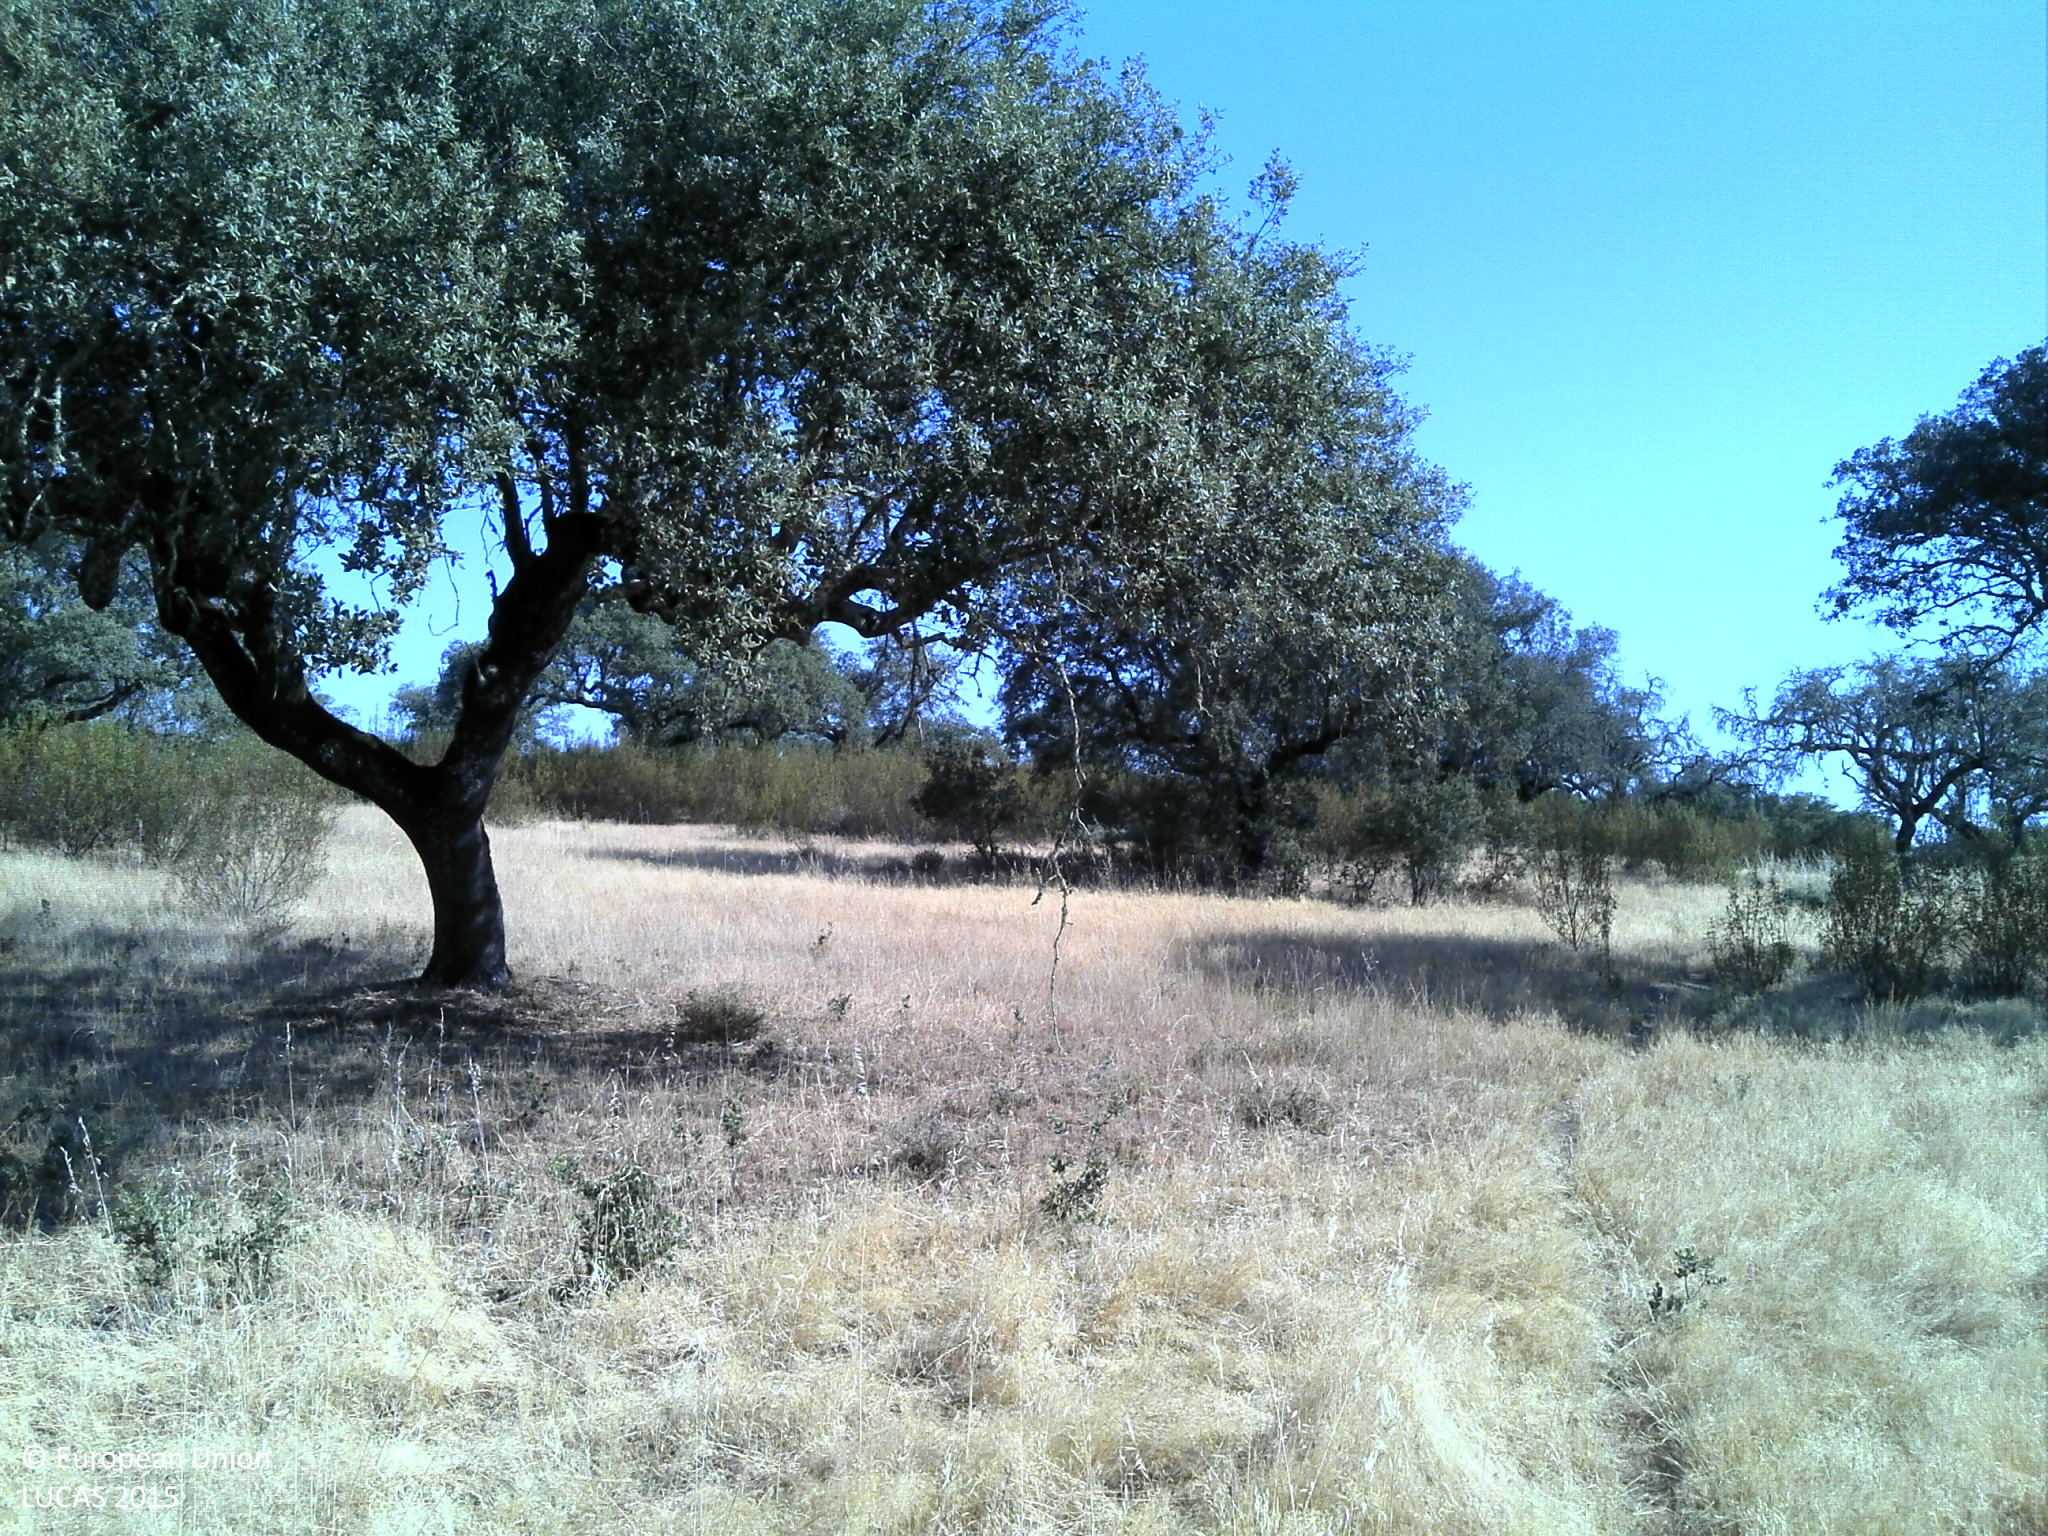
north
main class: Woodland
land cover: Broadleaved woodland
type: broadleaved evergreen forest
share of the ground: 10 - 25 %
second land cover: Grassland without tree/shrub cover
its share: 50 - 75 %
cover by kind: herbaceous plants 75 %, unconsolidated bare surface 15 %, broadleaved forest trees 10 %
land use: Forestry
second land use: Agriculture (excluding fallow land and kitchen gardens)
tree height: > 5 m
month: June
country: PT
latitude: 38.3161
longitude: -7.7706
